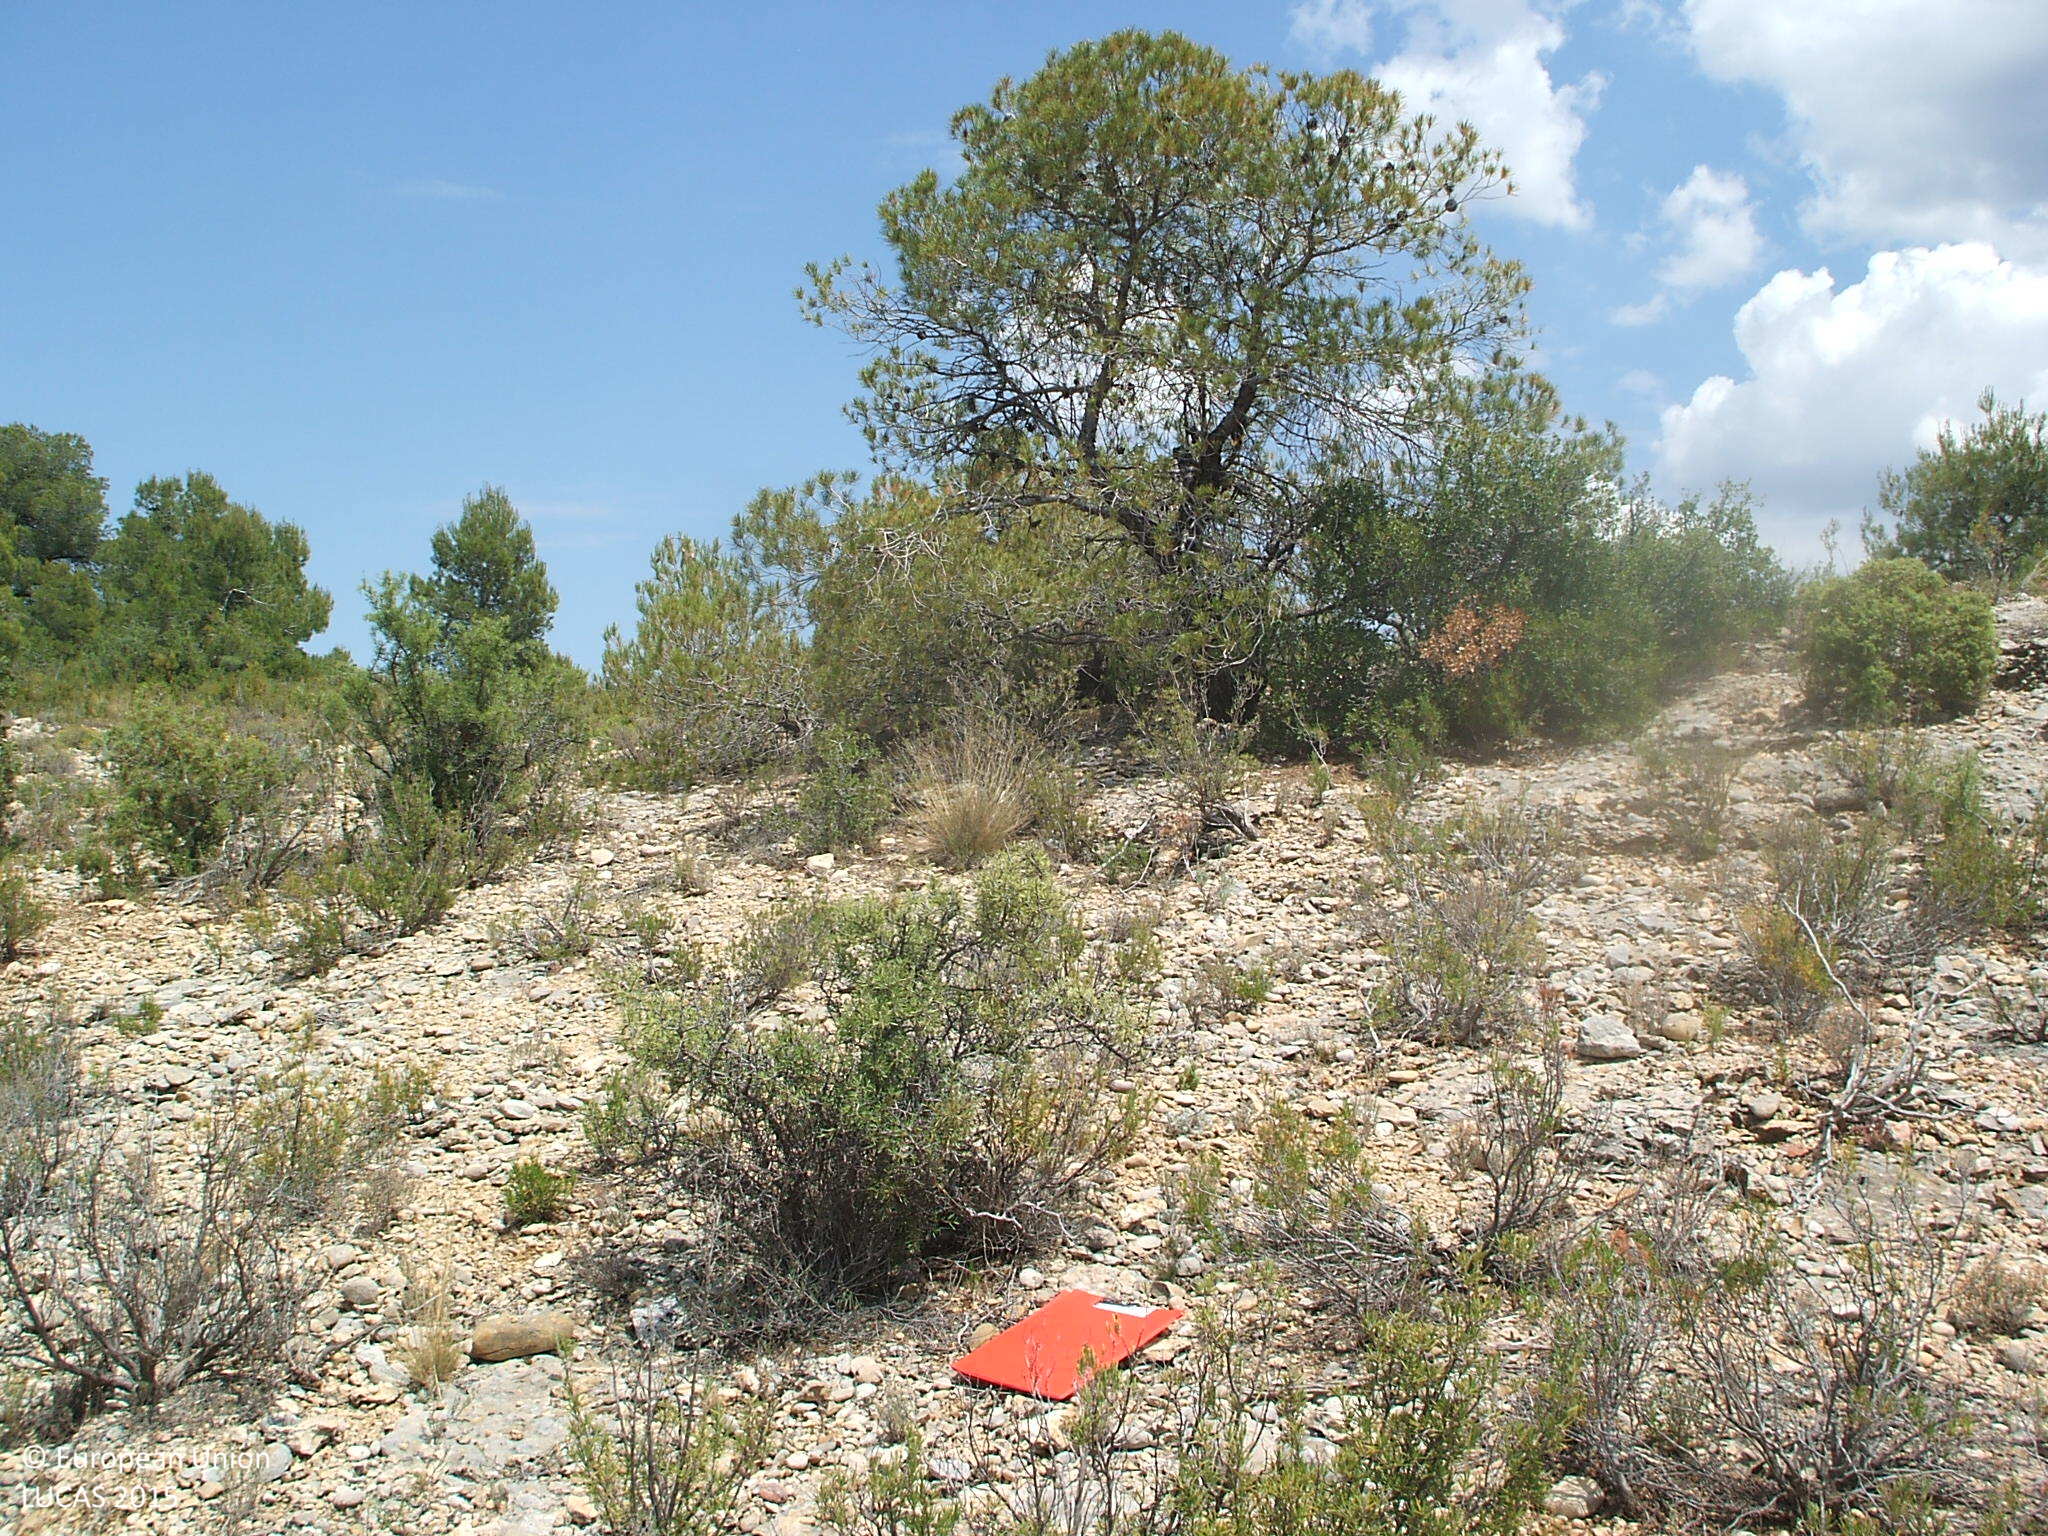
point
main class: Shrubland
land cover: Shrubland with sparse tree cover
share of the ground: 25 - 50 %
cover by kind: consolidated bare surface 75 %, shrubs 20 %, coniferous forest trees 5 %
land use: Semi-natural and natural areas not in use
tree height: < 5 m
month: June
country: ES
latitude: 40.8913
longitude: -0.1104
